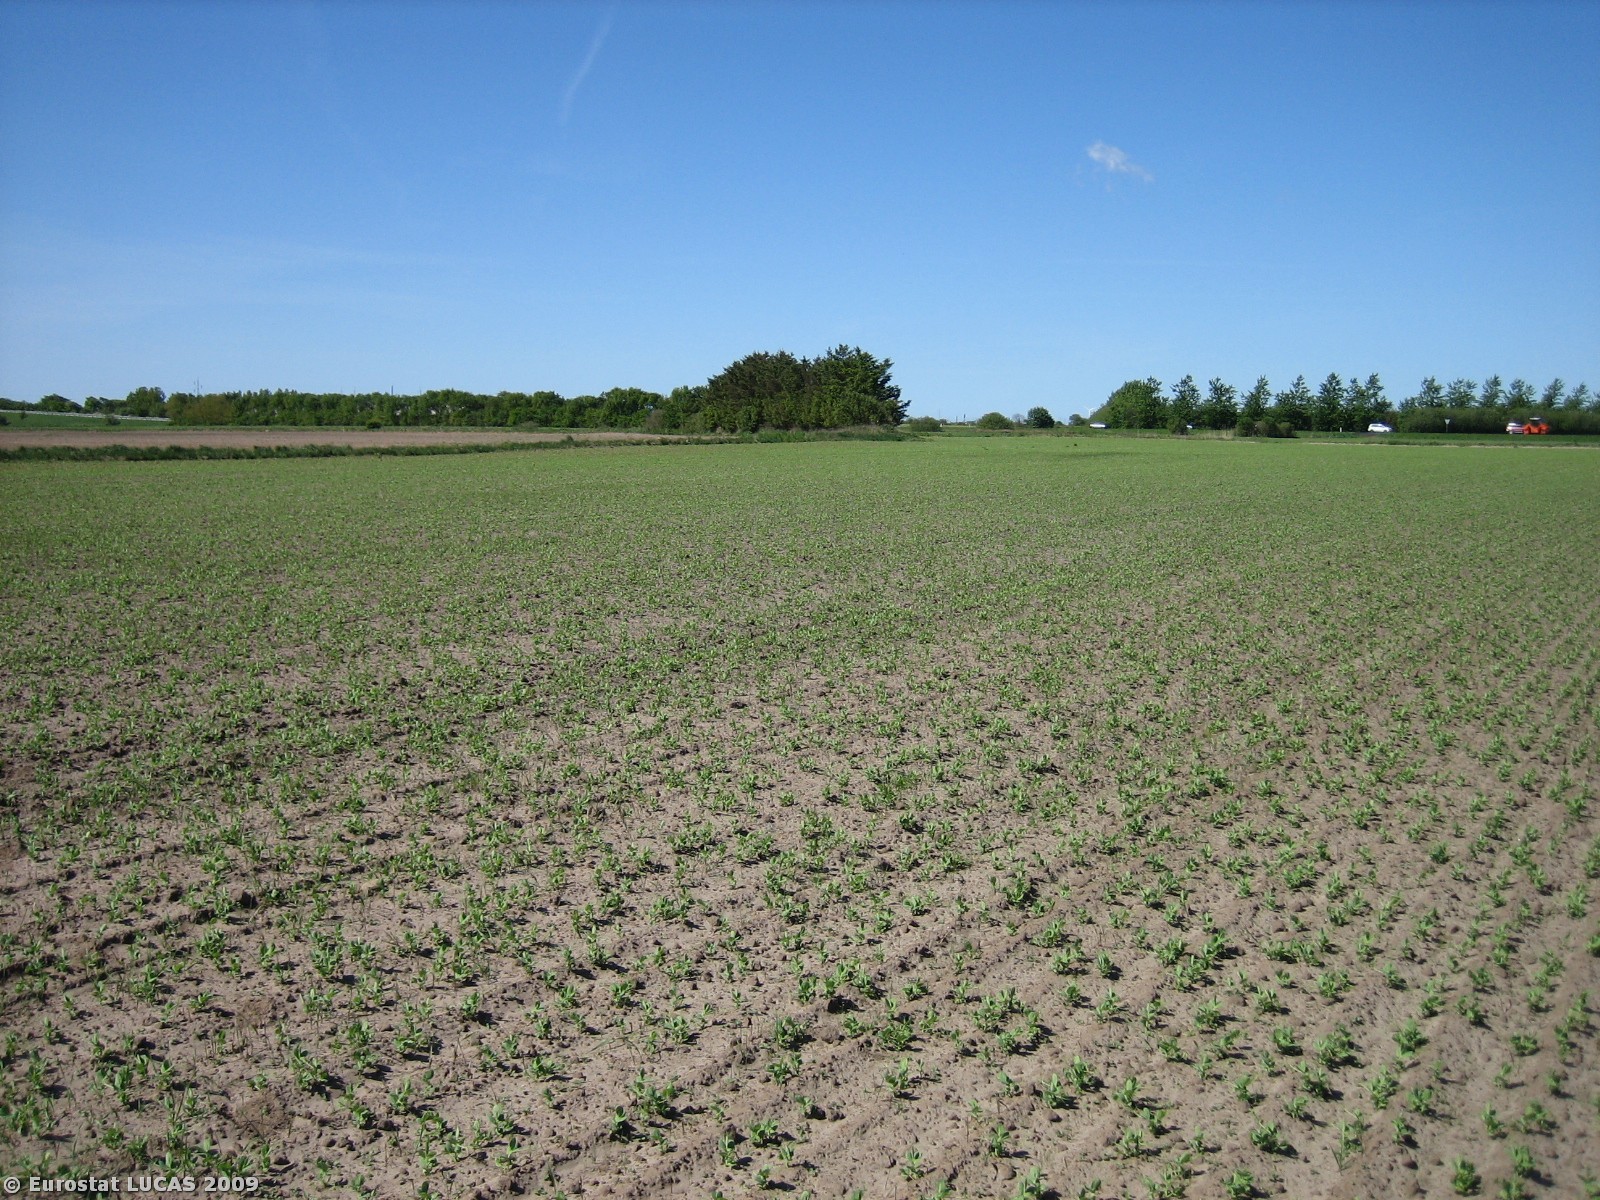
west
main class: Cropland
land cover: Dry pulses
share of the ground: 25 - 50 %
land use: Agriculture (excluding fallow land and kitchen gardens)
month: May
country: DK
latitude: 56.2849
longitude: 8.3380
